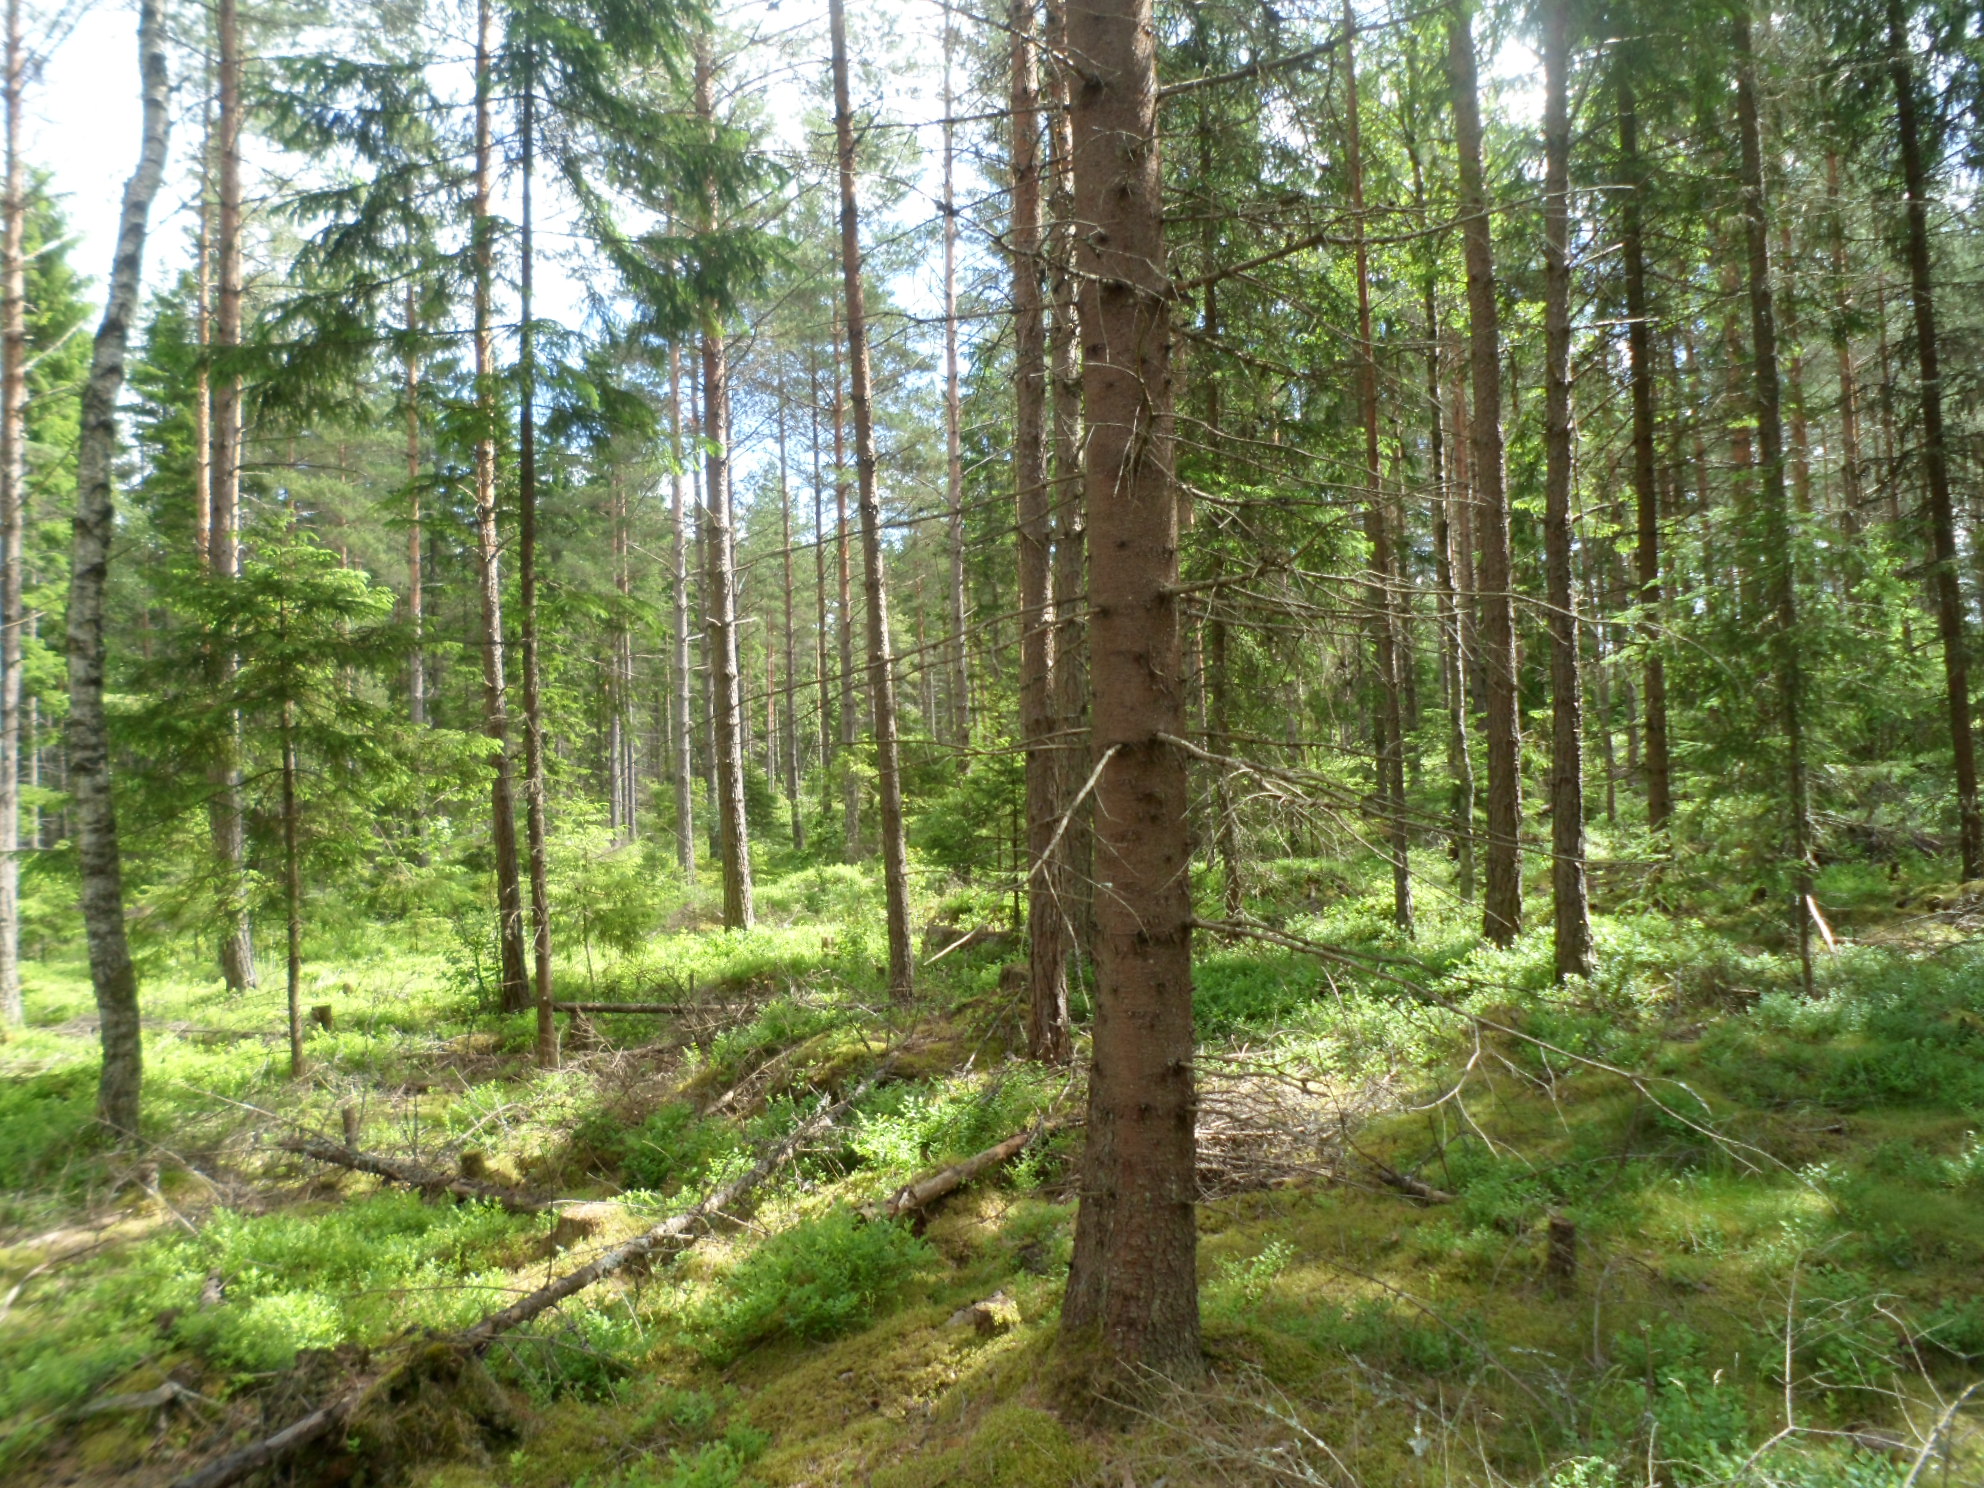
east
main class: Woodland
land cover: Pine dominated coniferous woodland
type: boreal forest
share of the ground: 50 - 75 %
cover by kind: coniferous forest trees 55 %, lichens and mosses 20 %, shrubs 15 %, herbaceous plants 10 %
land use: Forestry
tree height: > 5 m
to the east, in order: Pine dominated coniferous woodland; Tracks; Pine dominated coniferous woodland; Tracks; Pine dominated coniferous woodland; Tracks; Pine dominated coniferous woodland; Tracks; Pine dominated coniferous woodland; Pine dominated mixed woodland; Broadleaved woodland; Shrubland with sparse tree cover; Pine dominated mixed woodland; Pine dominated coniferous woodland
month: June
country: SE
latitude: 57.1606
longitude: 14.8080
